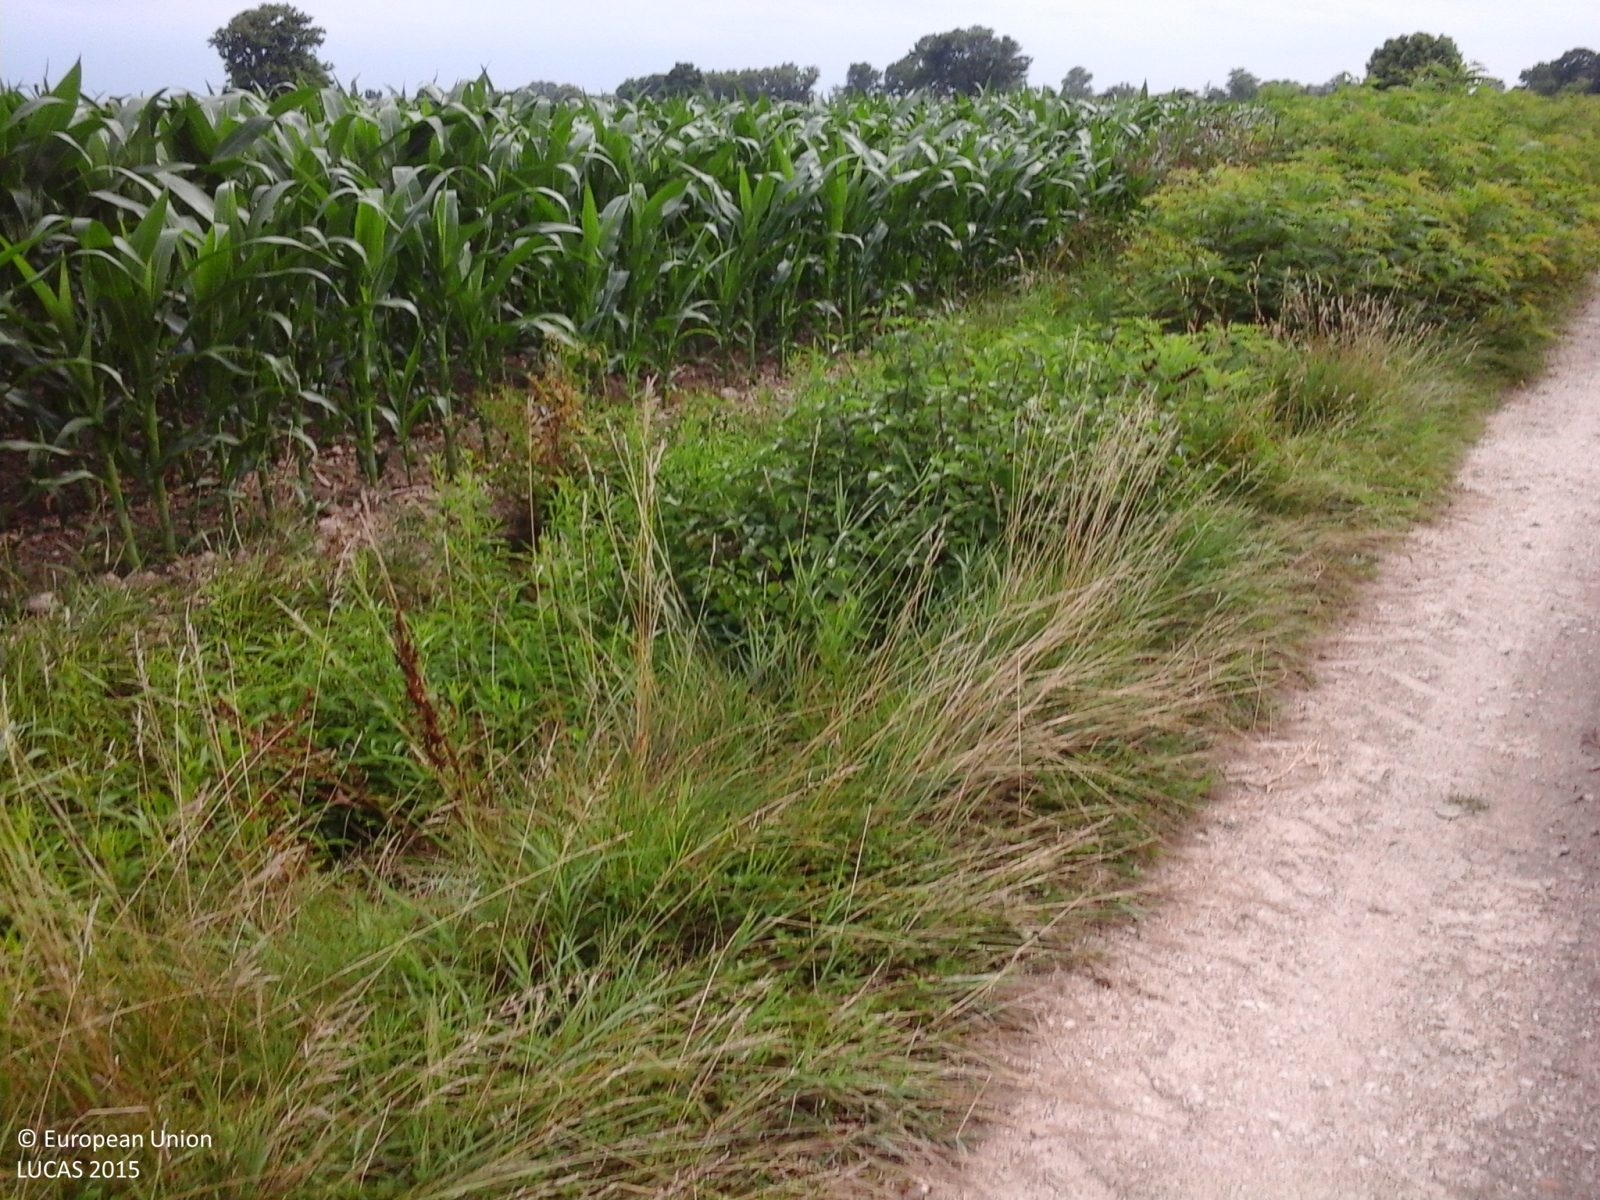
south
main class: Cropland
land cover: Maize
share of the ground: > 75 %
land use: Agriculture (excluding fallow land and kitchen gardens)
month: June
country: IT
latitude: 45.8340
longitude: 12.5585
